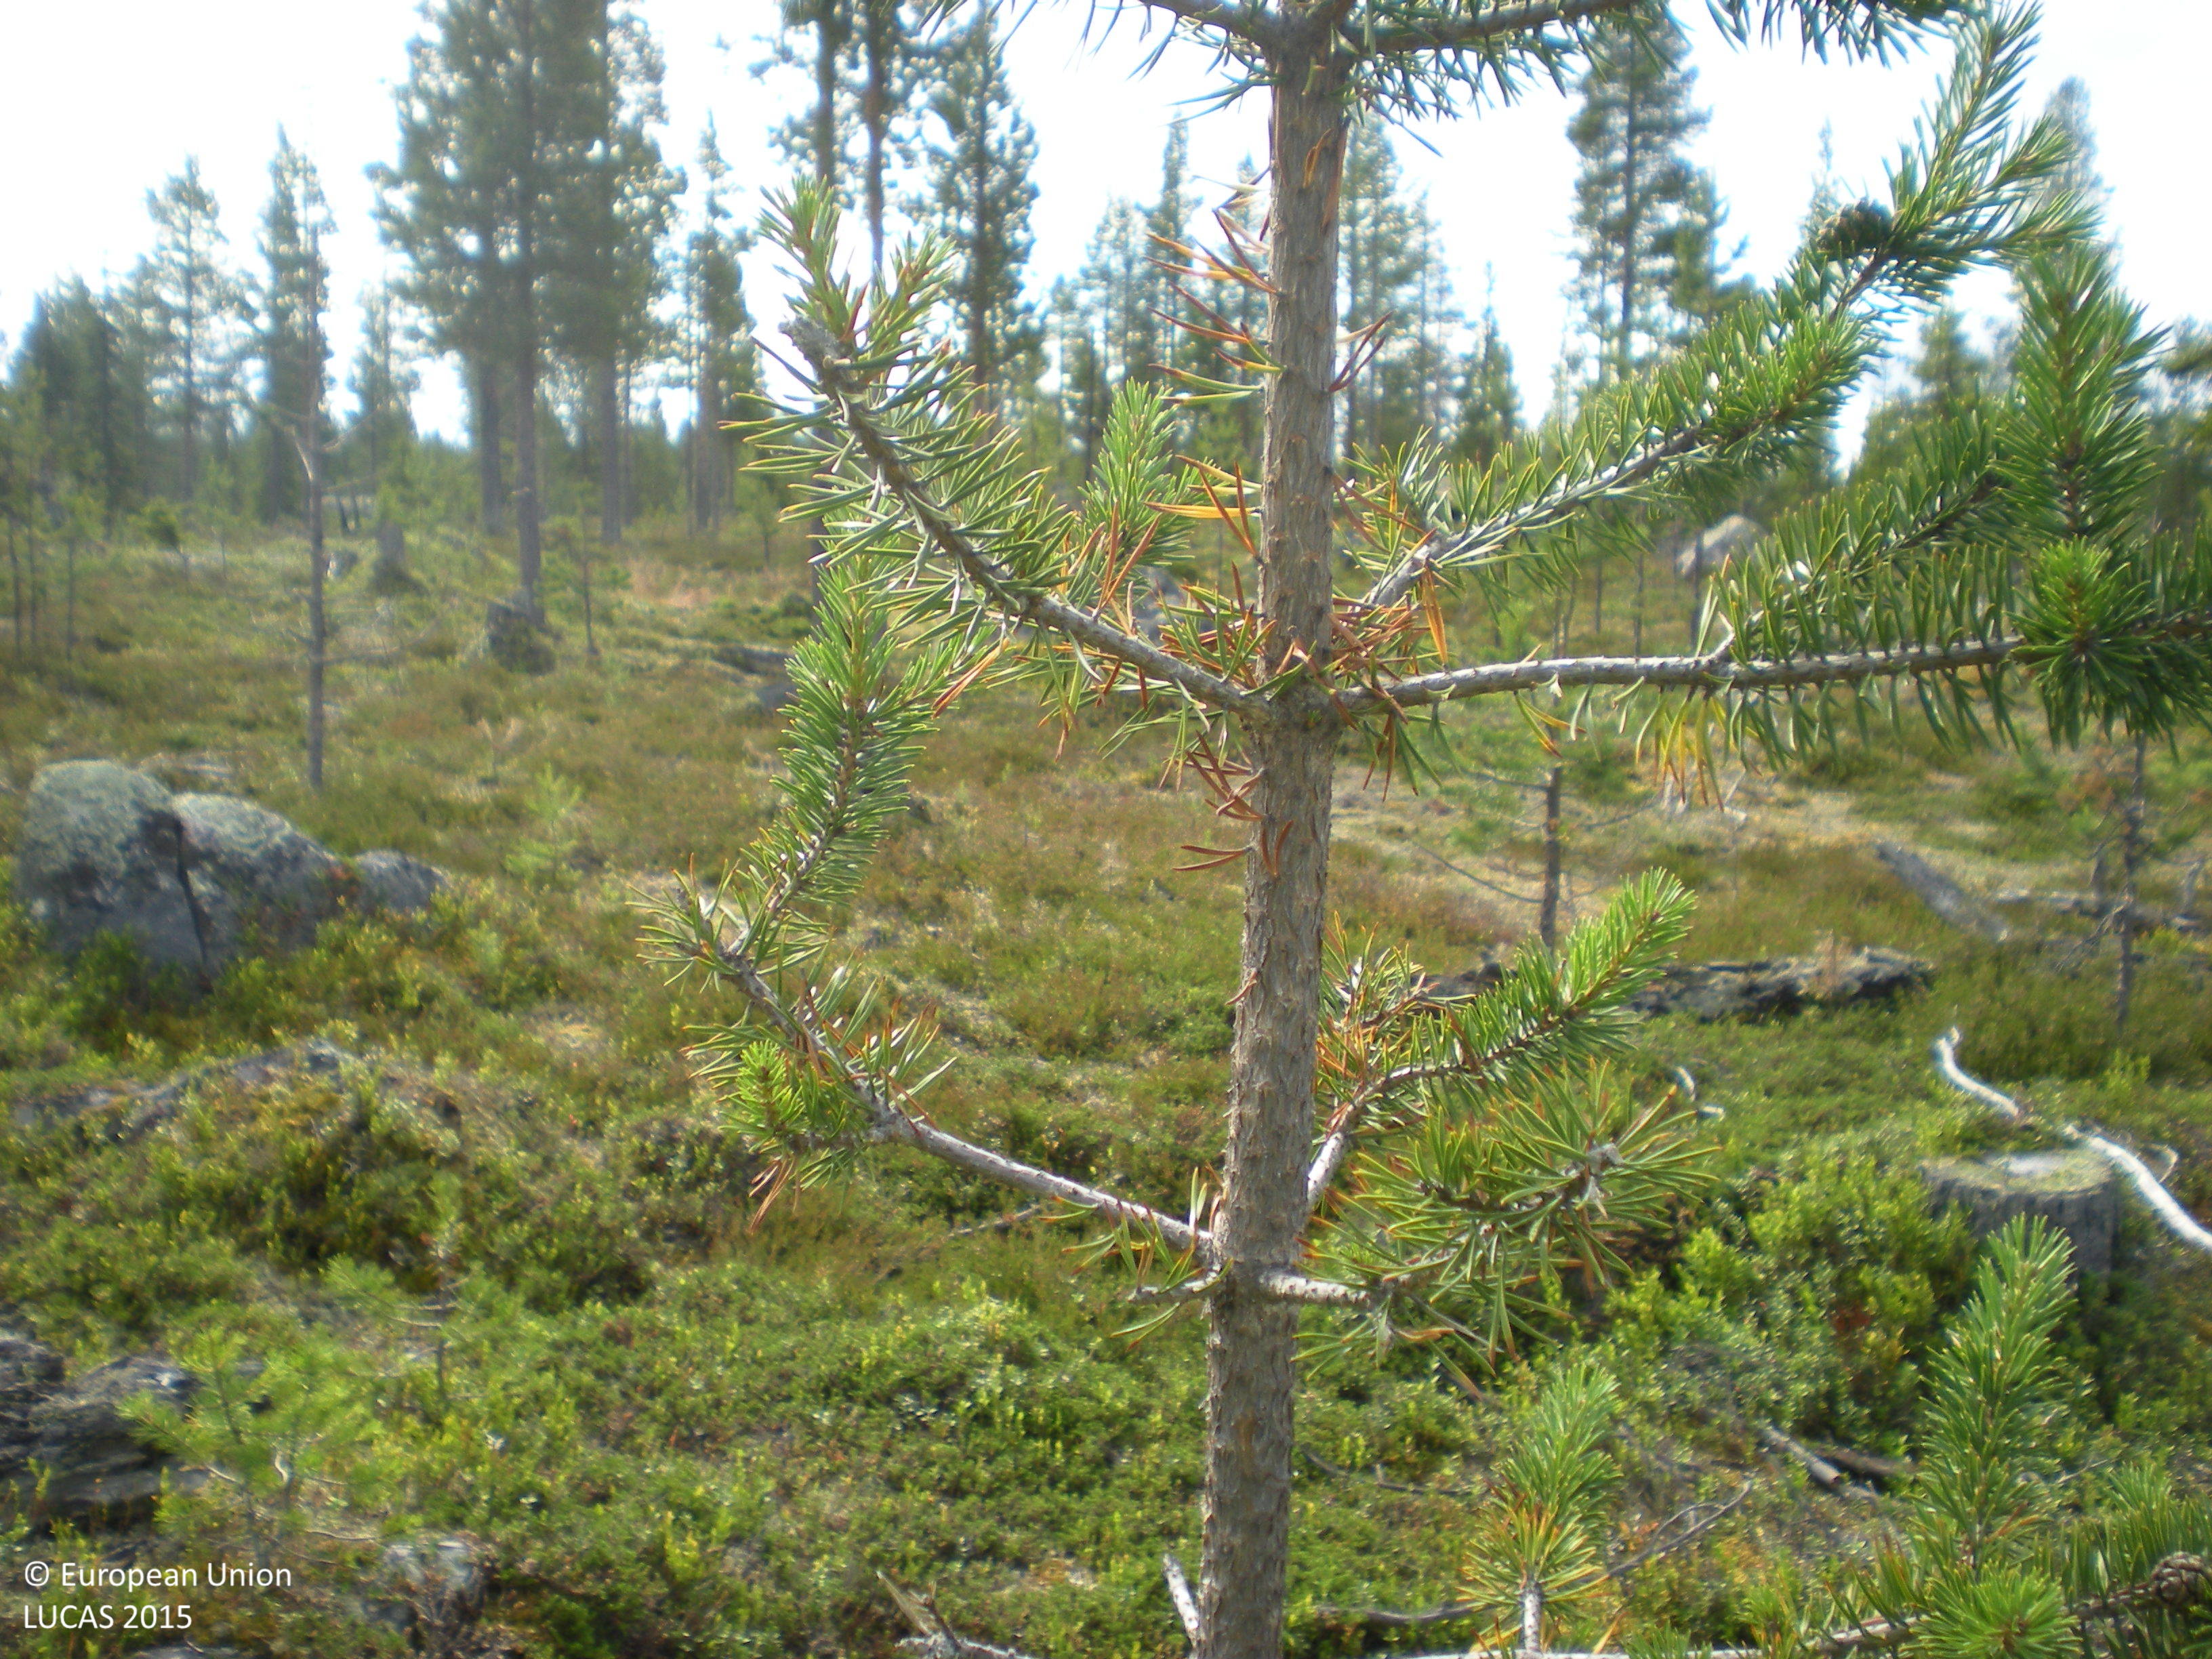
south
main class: Woodland
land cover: Pine dominated coniferous woodland
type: boreal forest
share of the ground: 25 - 50 %
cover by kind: shrubs 50 %, coniferous forest trees 30 %, lichens and mosses 10 %, consolidated bare surface 5 %
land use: Forestry
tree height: < 5 m
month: August
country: SE
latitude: 65.8464
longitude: 18.0824
